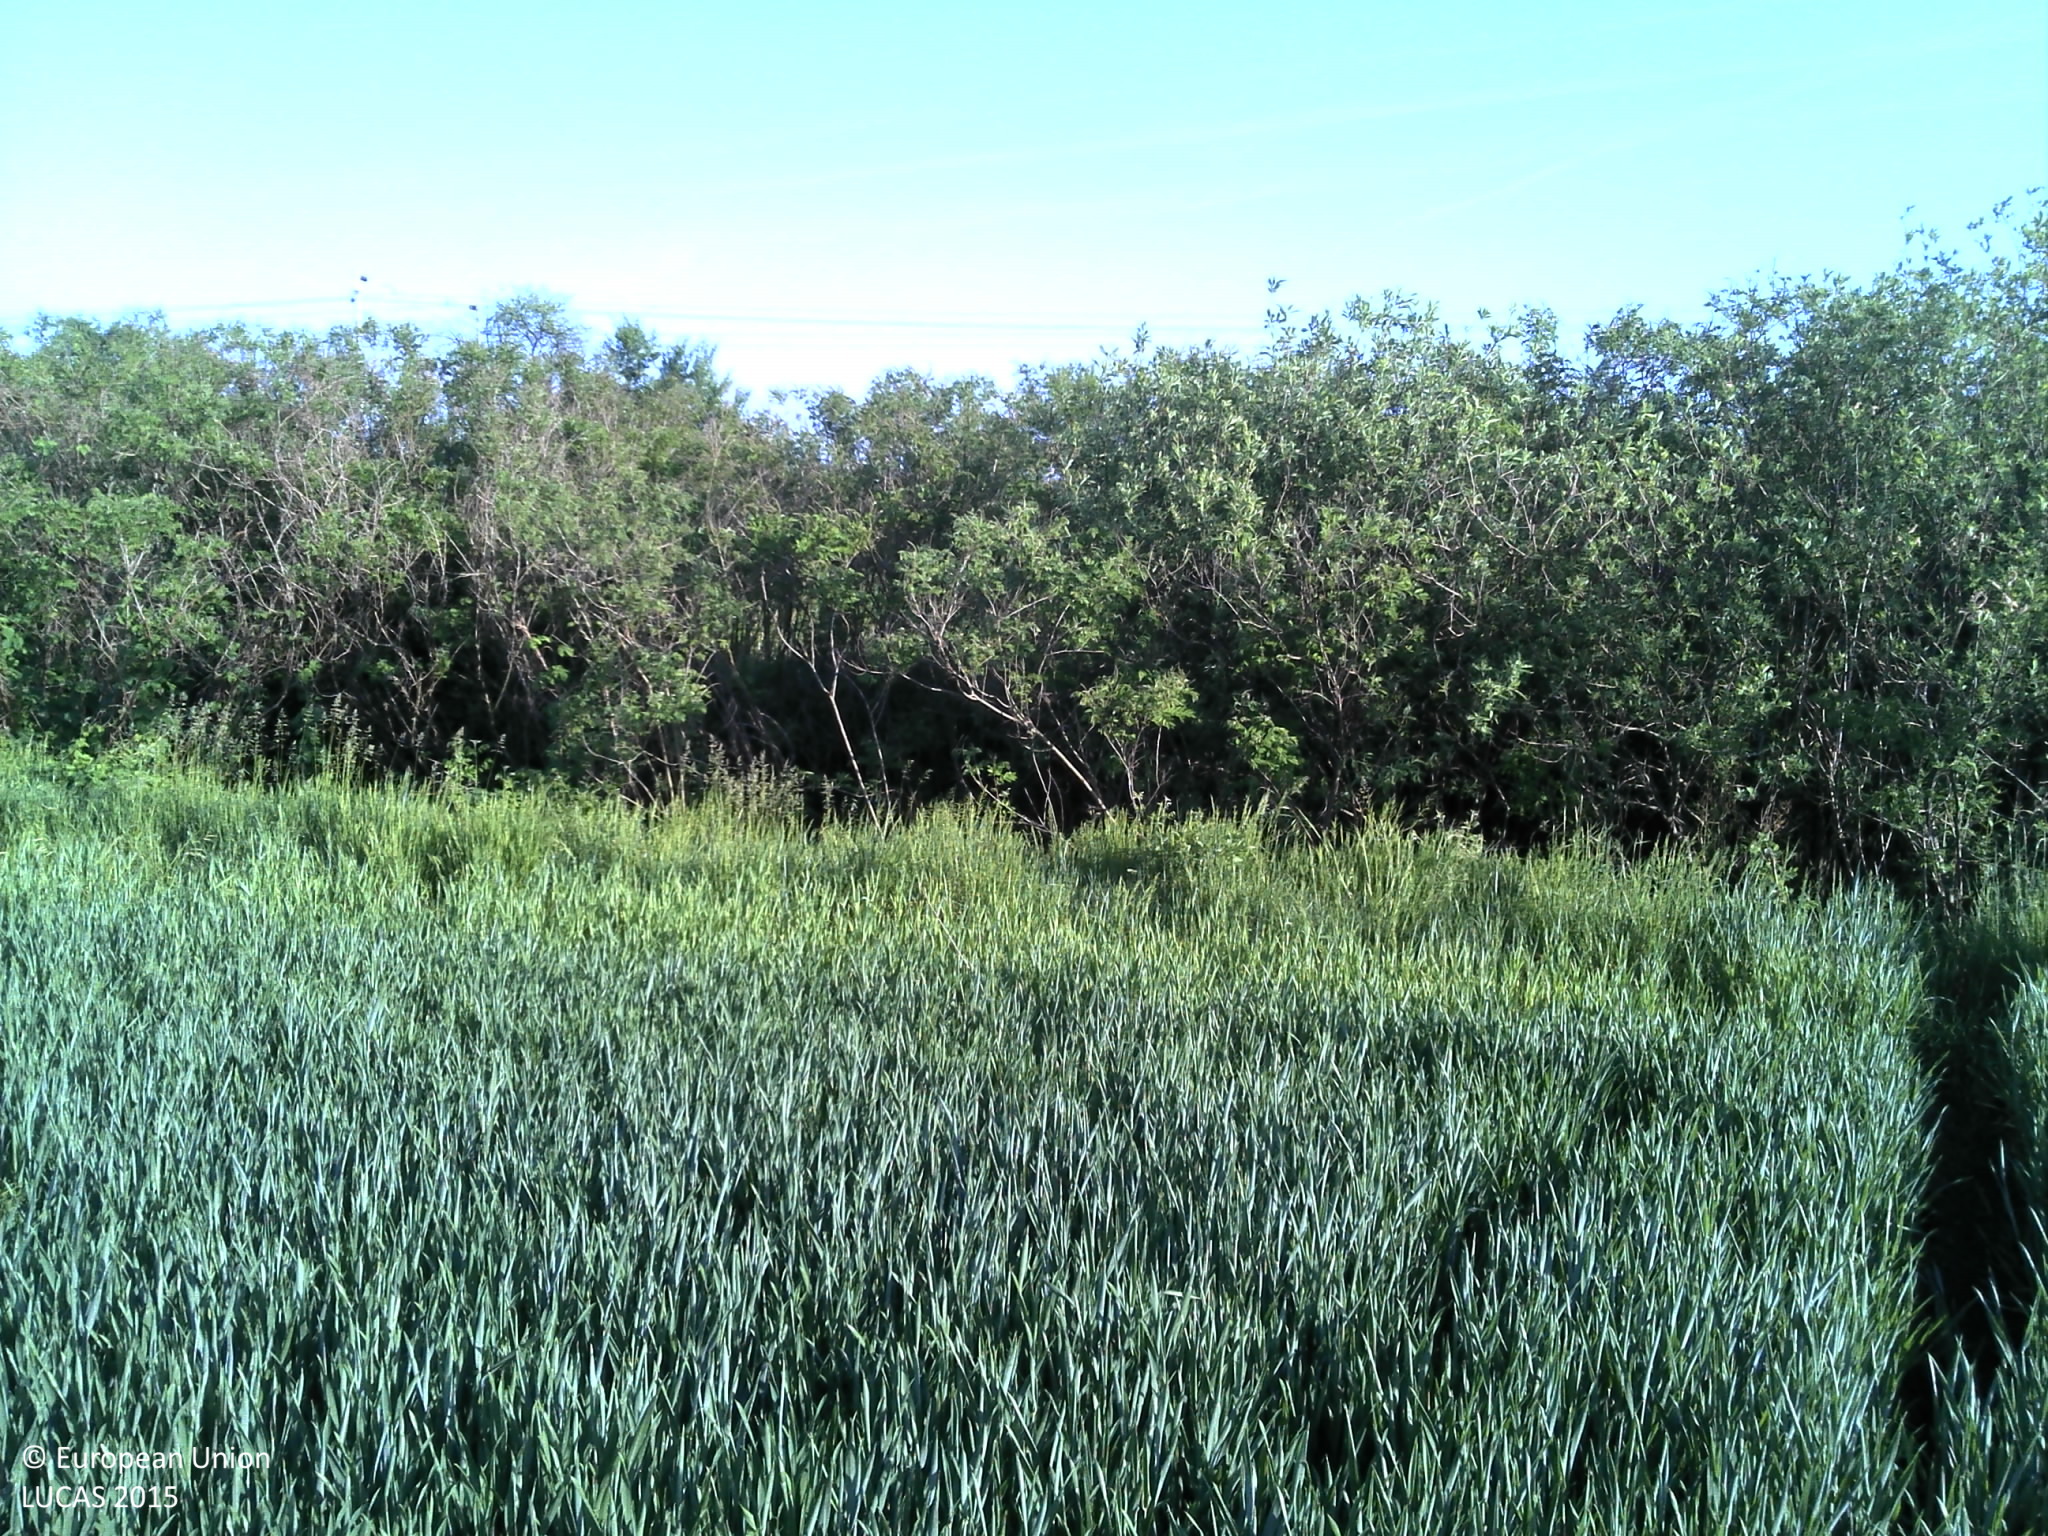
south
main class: Cropland
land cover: Common wheat
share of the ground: > 75 %
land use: Agriculture (excluding fallow land and kitchen gardens)
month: May
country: HR
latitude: 45.1821
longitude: 18.2375
